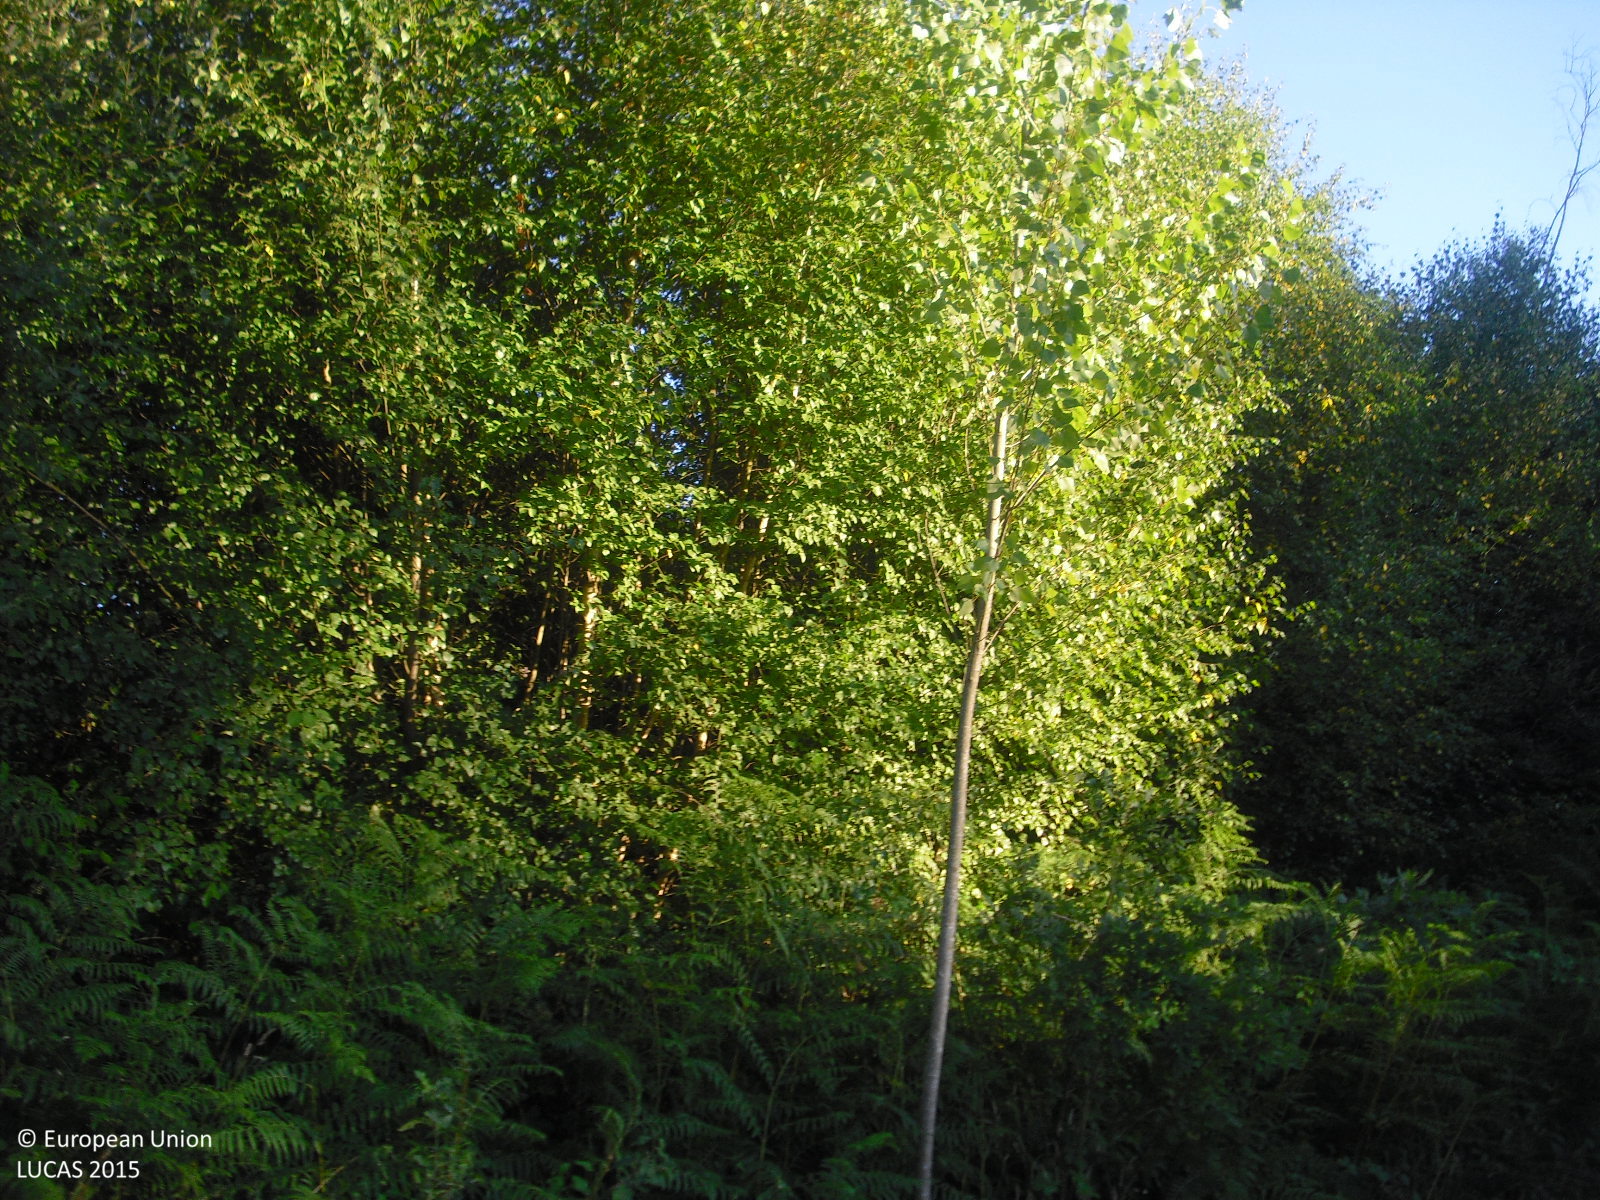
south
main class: Grassland
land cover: Grassland without tree/shrub cover
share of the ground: > 75 %
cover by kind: herbaceous plants 100 %
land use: Agriculture (excluding fallow land and kitchen gardens)
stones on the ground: < 10 %
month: July
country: ES
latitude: 42.2585
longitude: -7.6094
